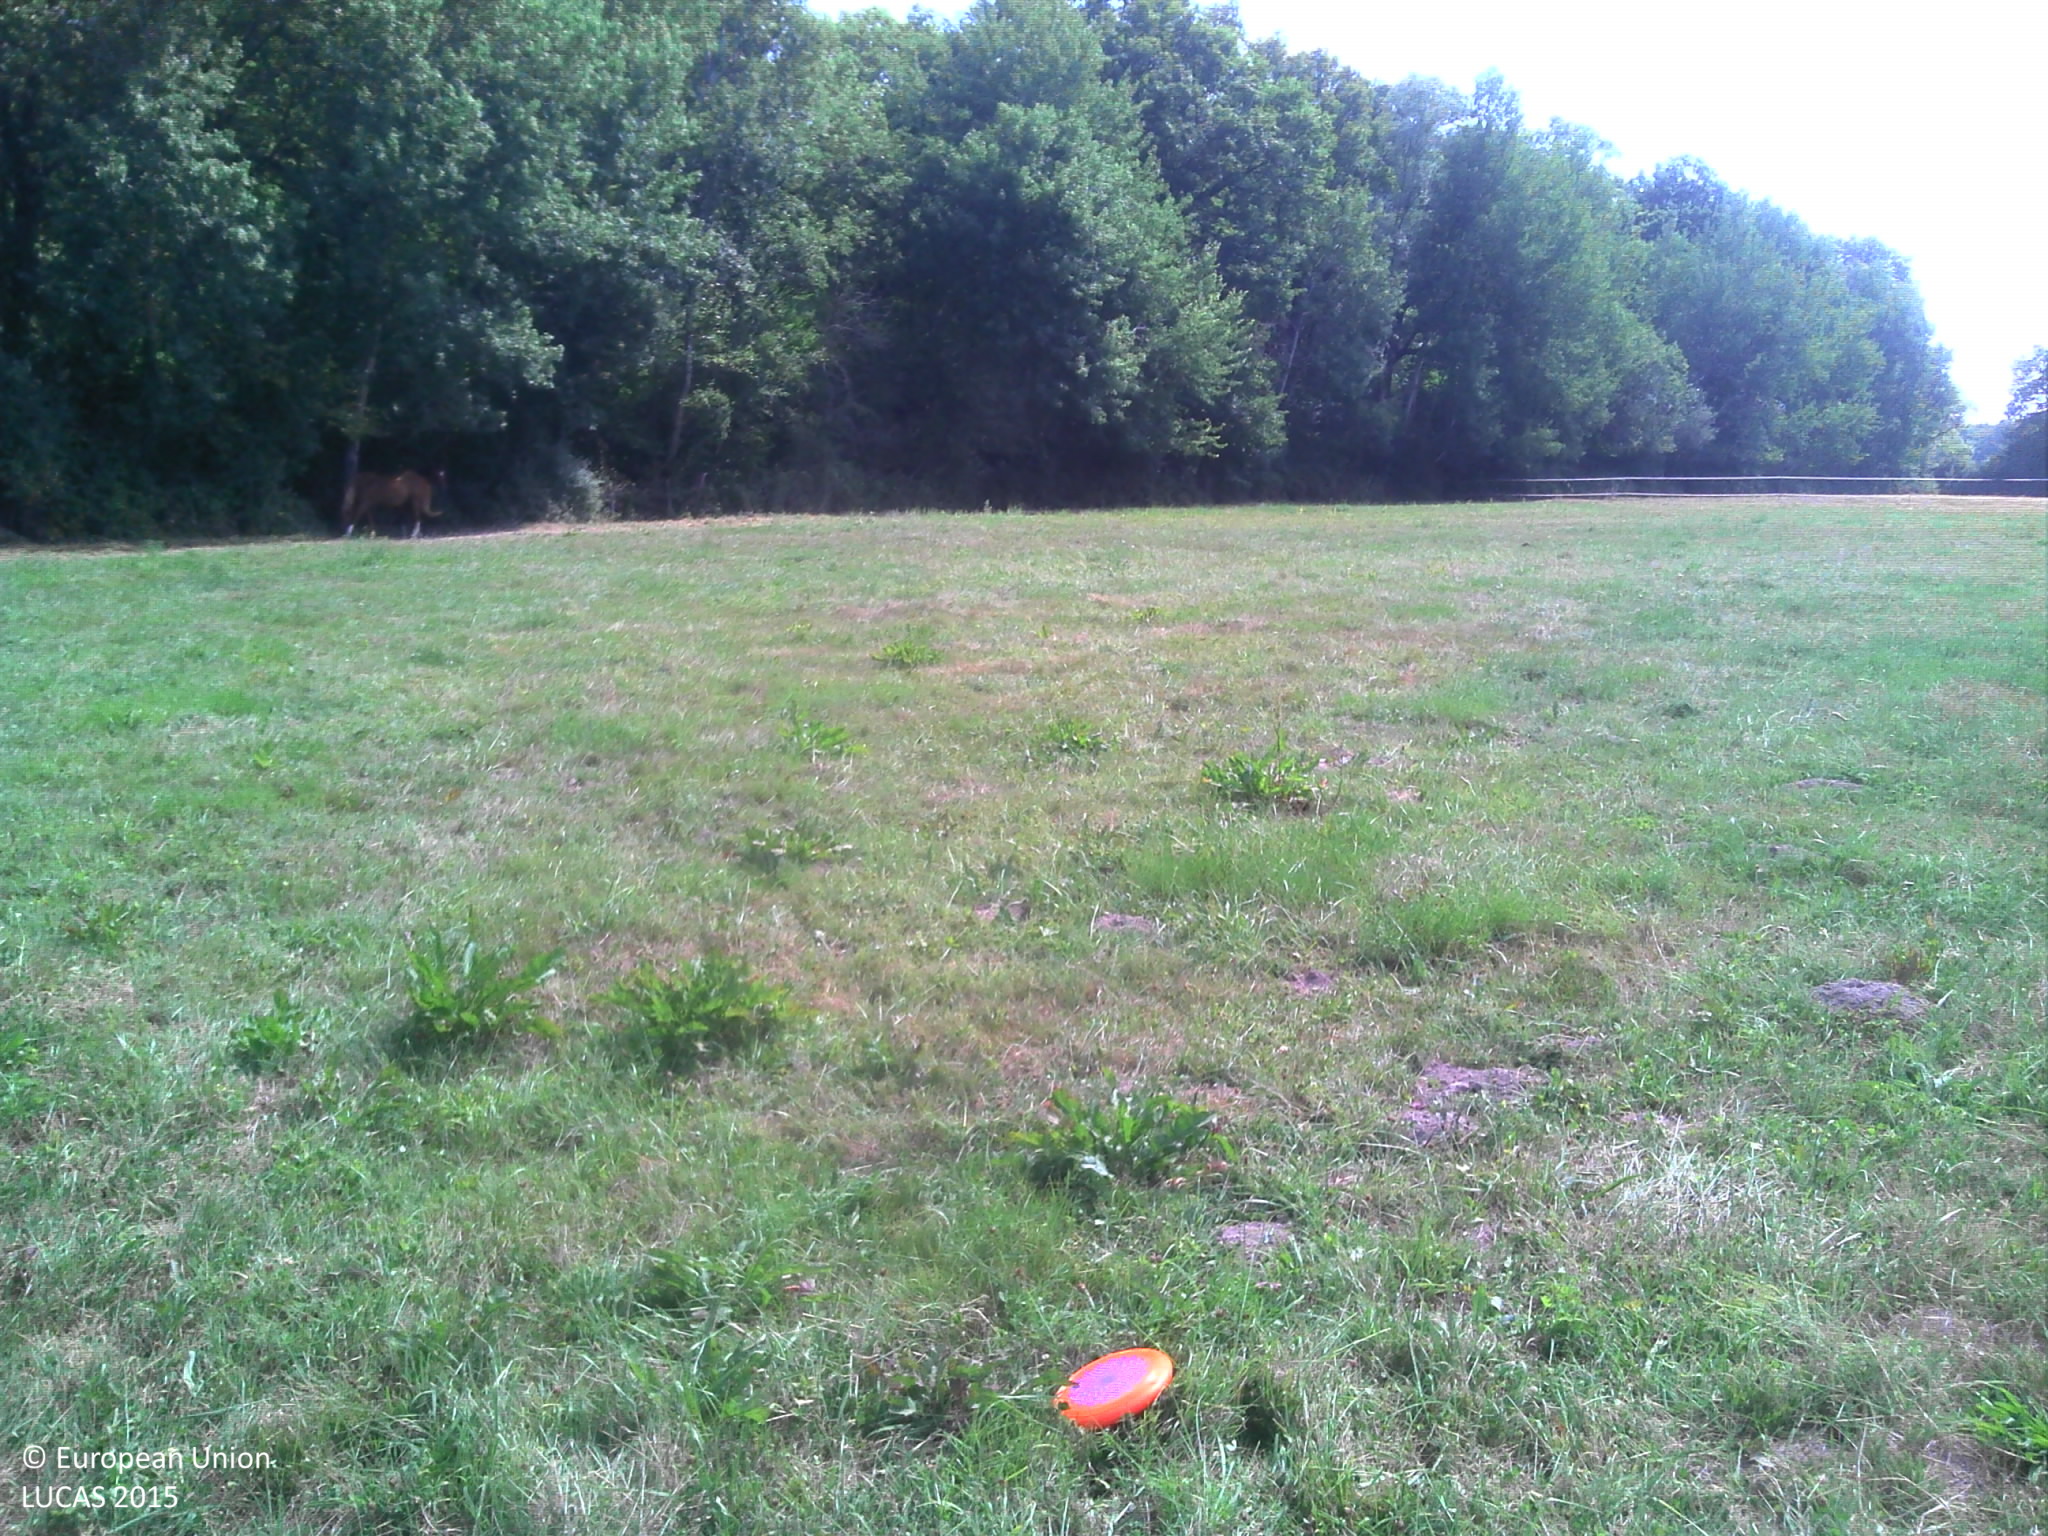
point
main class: Grassland
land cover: Grassland without tree/shrub cover
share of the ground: > 75 %
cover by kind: herbaceous plants 100 %
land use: Agriculture (excluding fallow land and kitchen gardens)
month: July
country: FR
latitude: 46.8887
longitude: 5.1062
